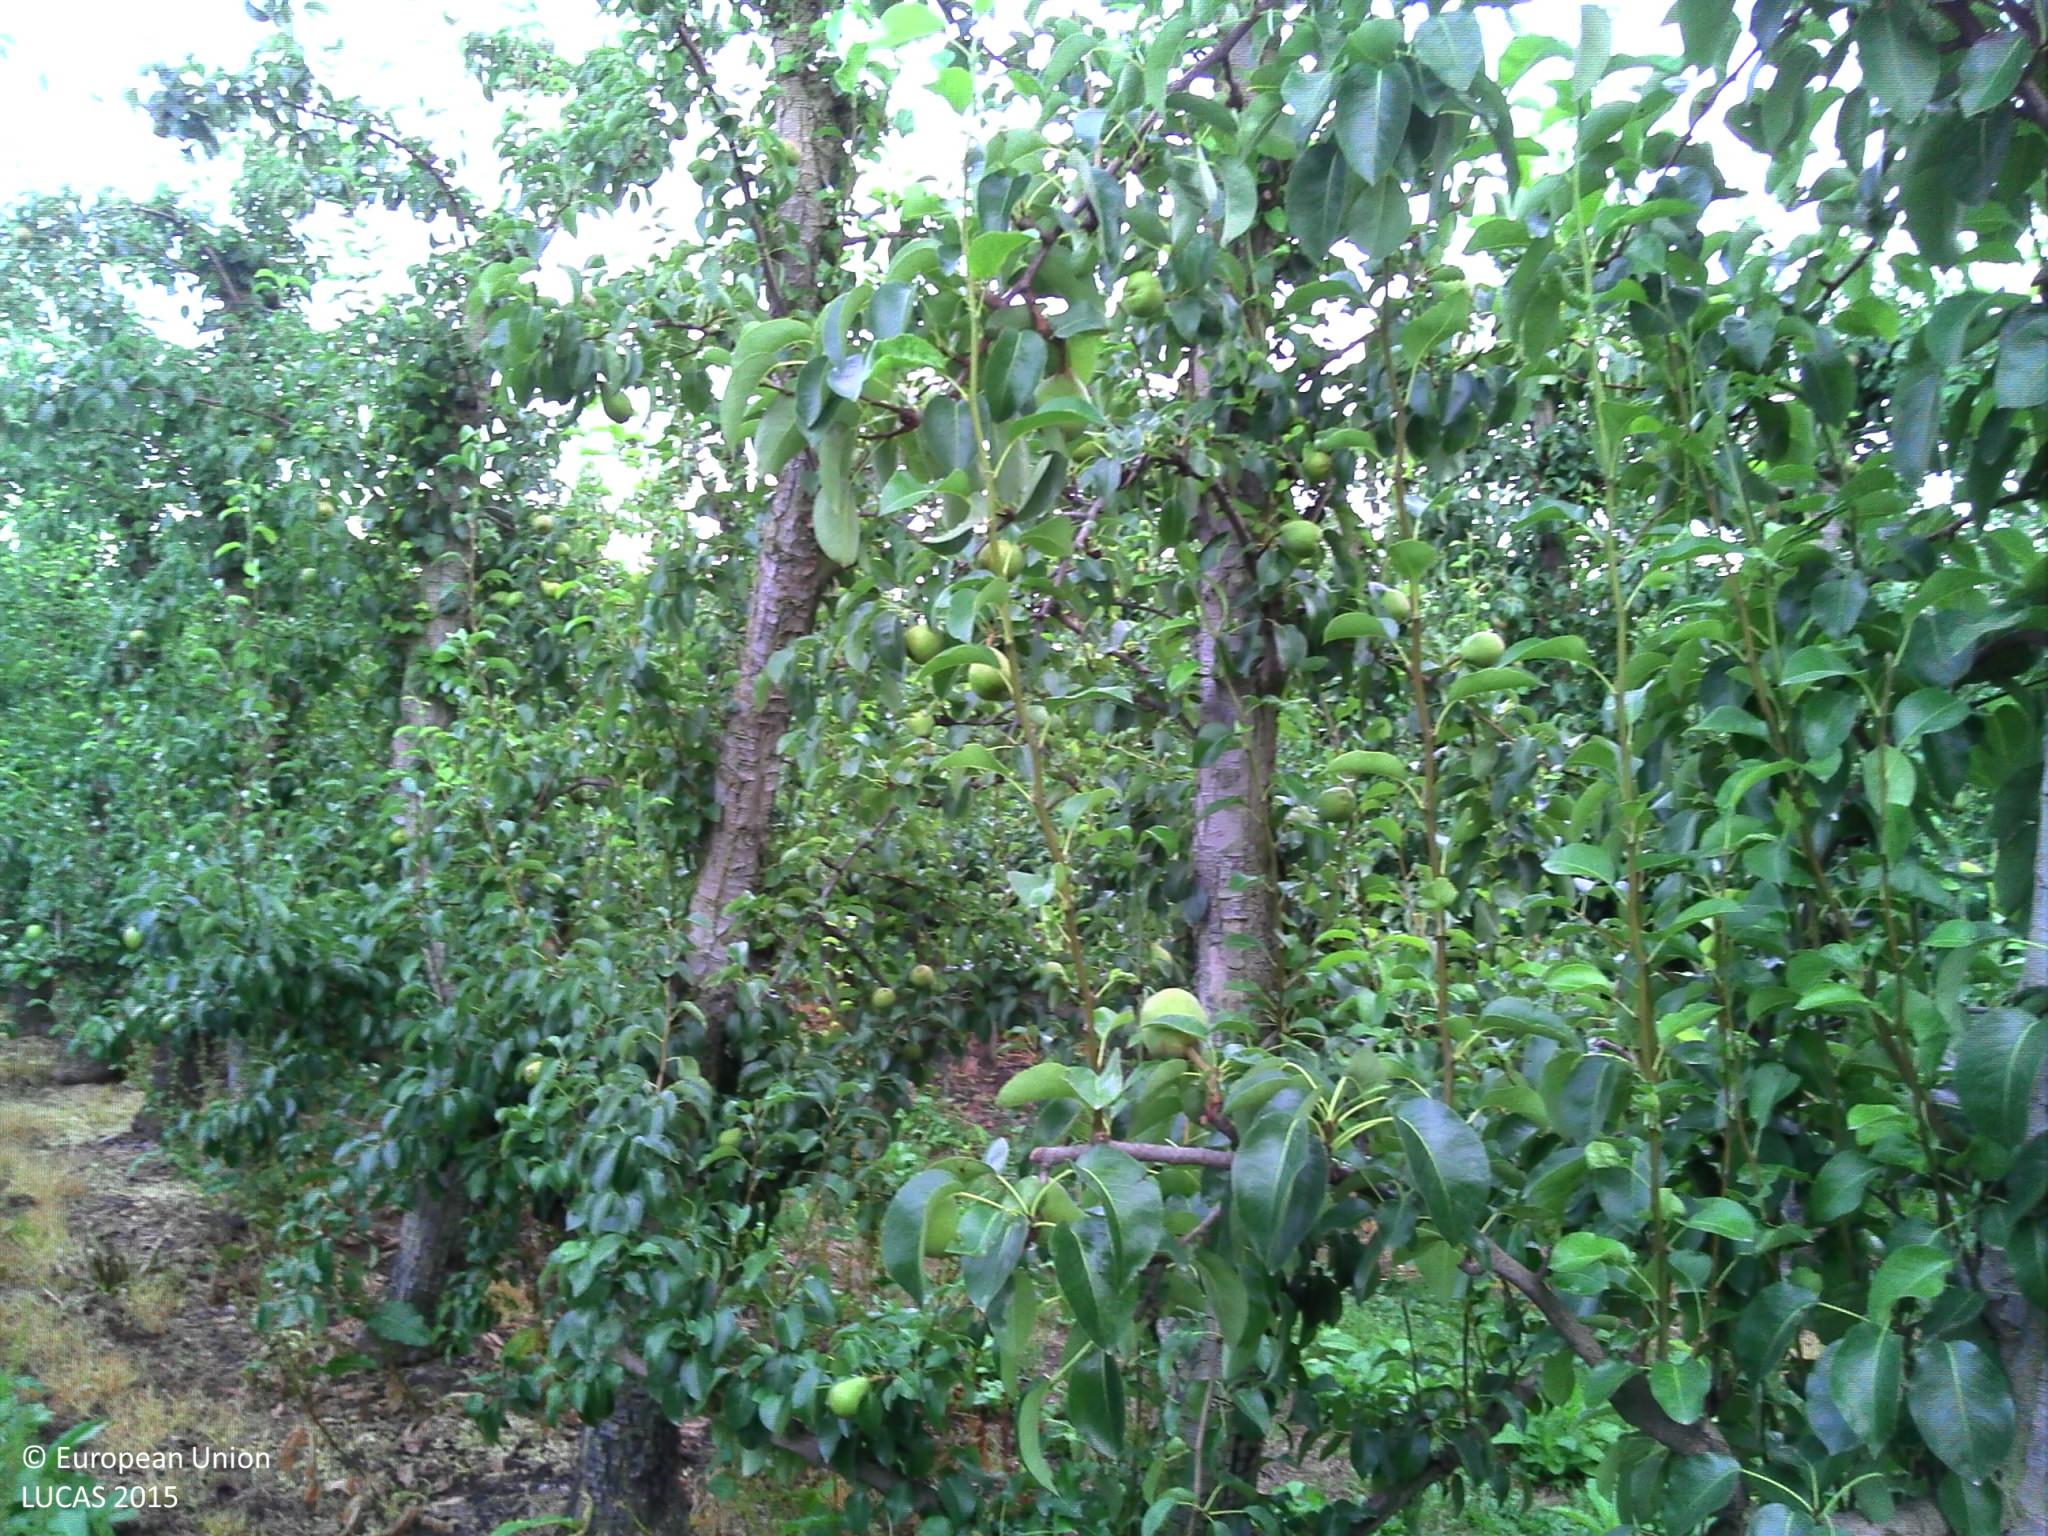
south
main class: Cropland
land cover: Pear fruit
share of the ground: 50 - 75 %
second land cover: Spontaneously vegetated surfaces
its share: 25 - 50 %
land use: Agriculture (excluding fallow land and kitchen gardens)
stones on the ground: < 10 %
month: July
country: BE
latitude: 50.8737
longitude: 5.1515
